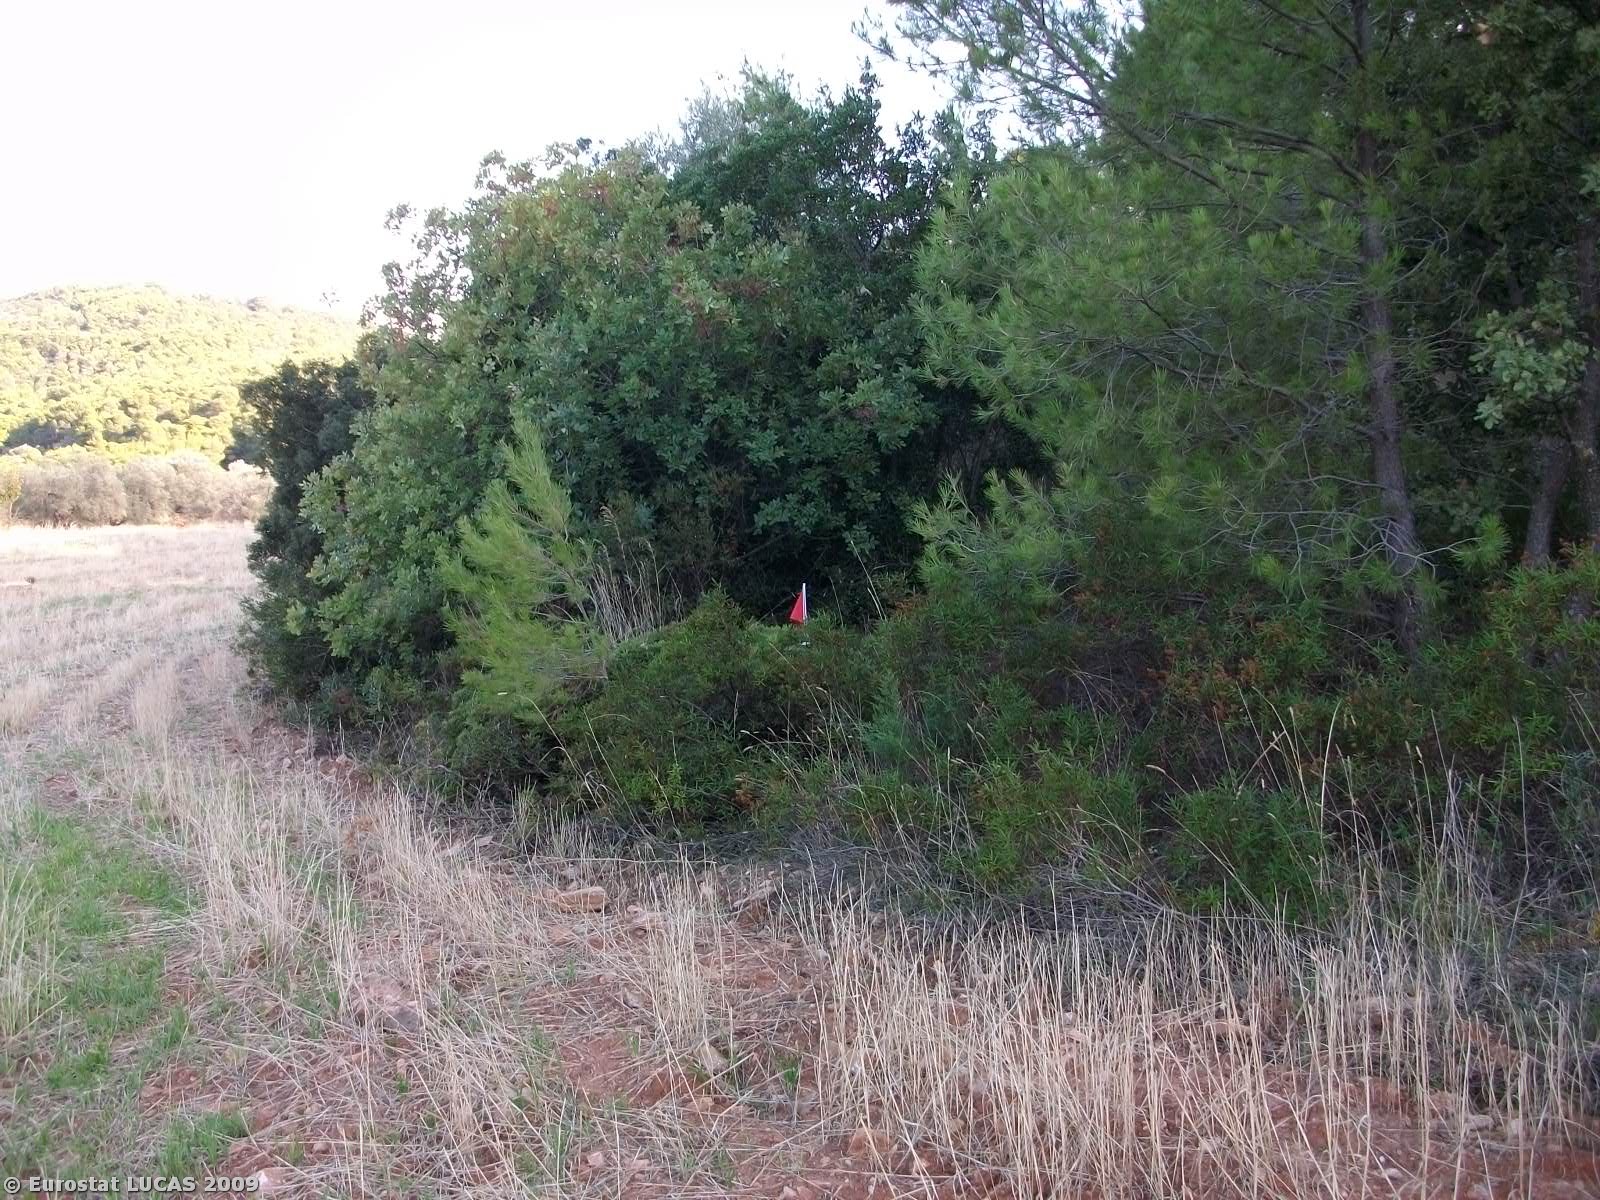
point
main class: Woodland
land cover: Mixed woodland
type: coniferous forest of the mediterranean region
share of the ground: > 75 %
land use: Forestry
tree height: > 5 m
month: September
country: GR
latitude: 38.2301
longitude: 24.0043
